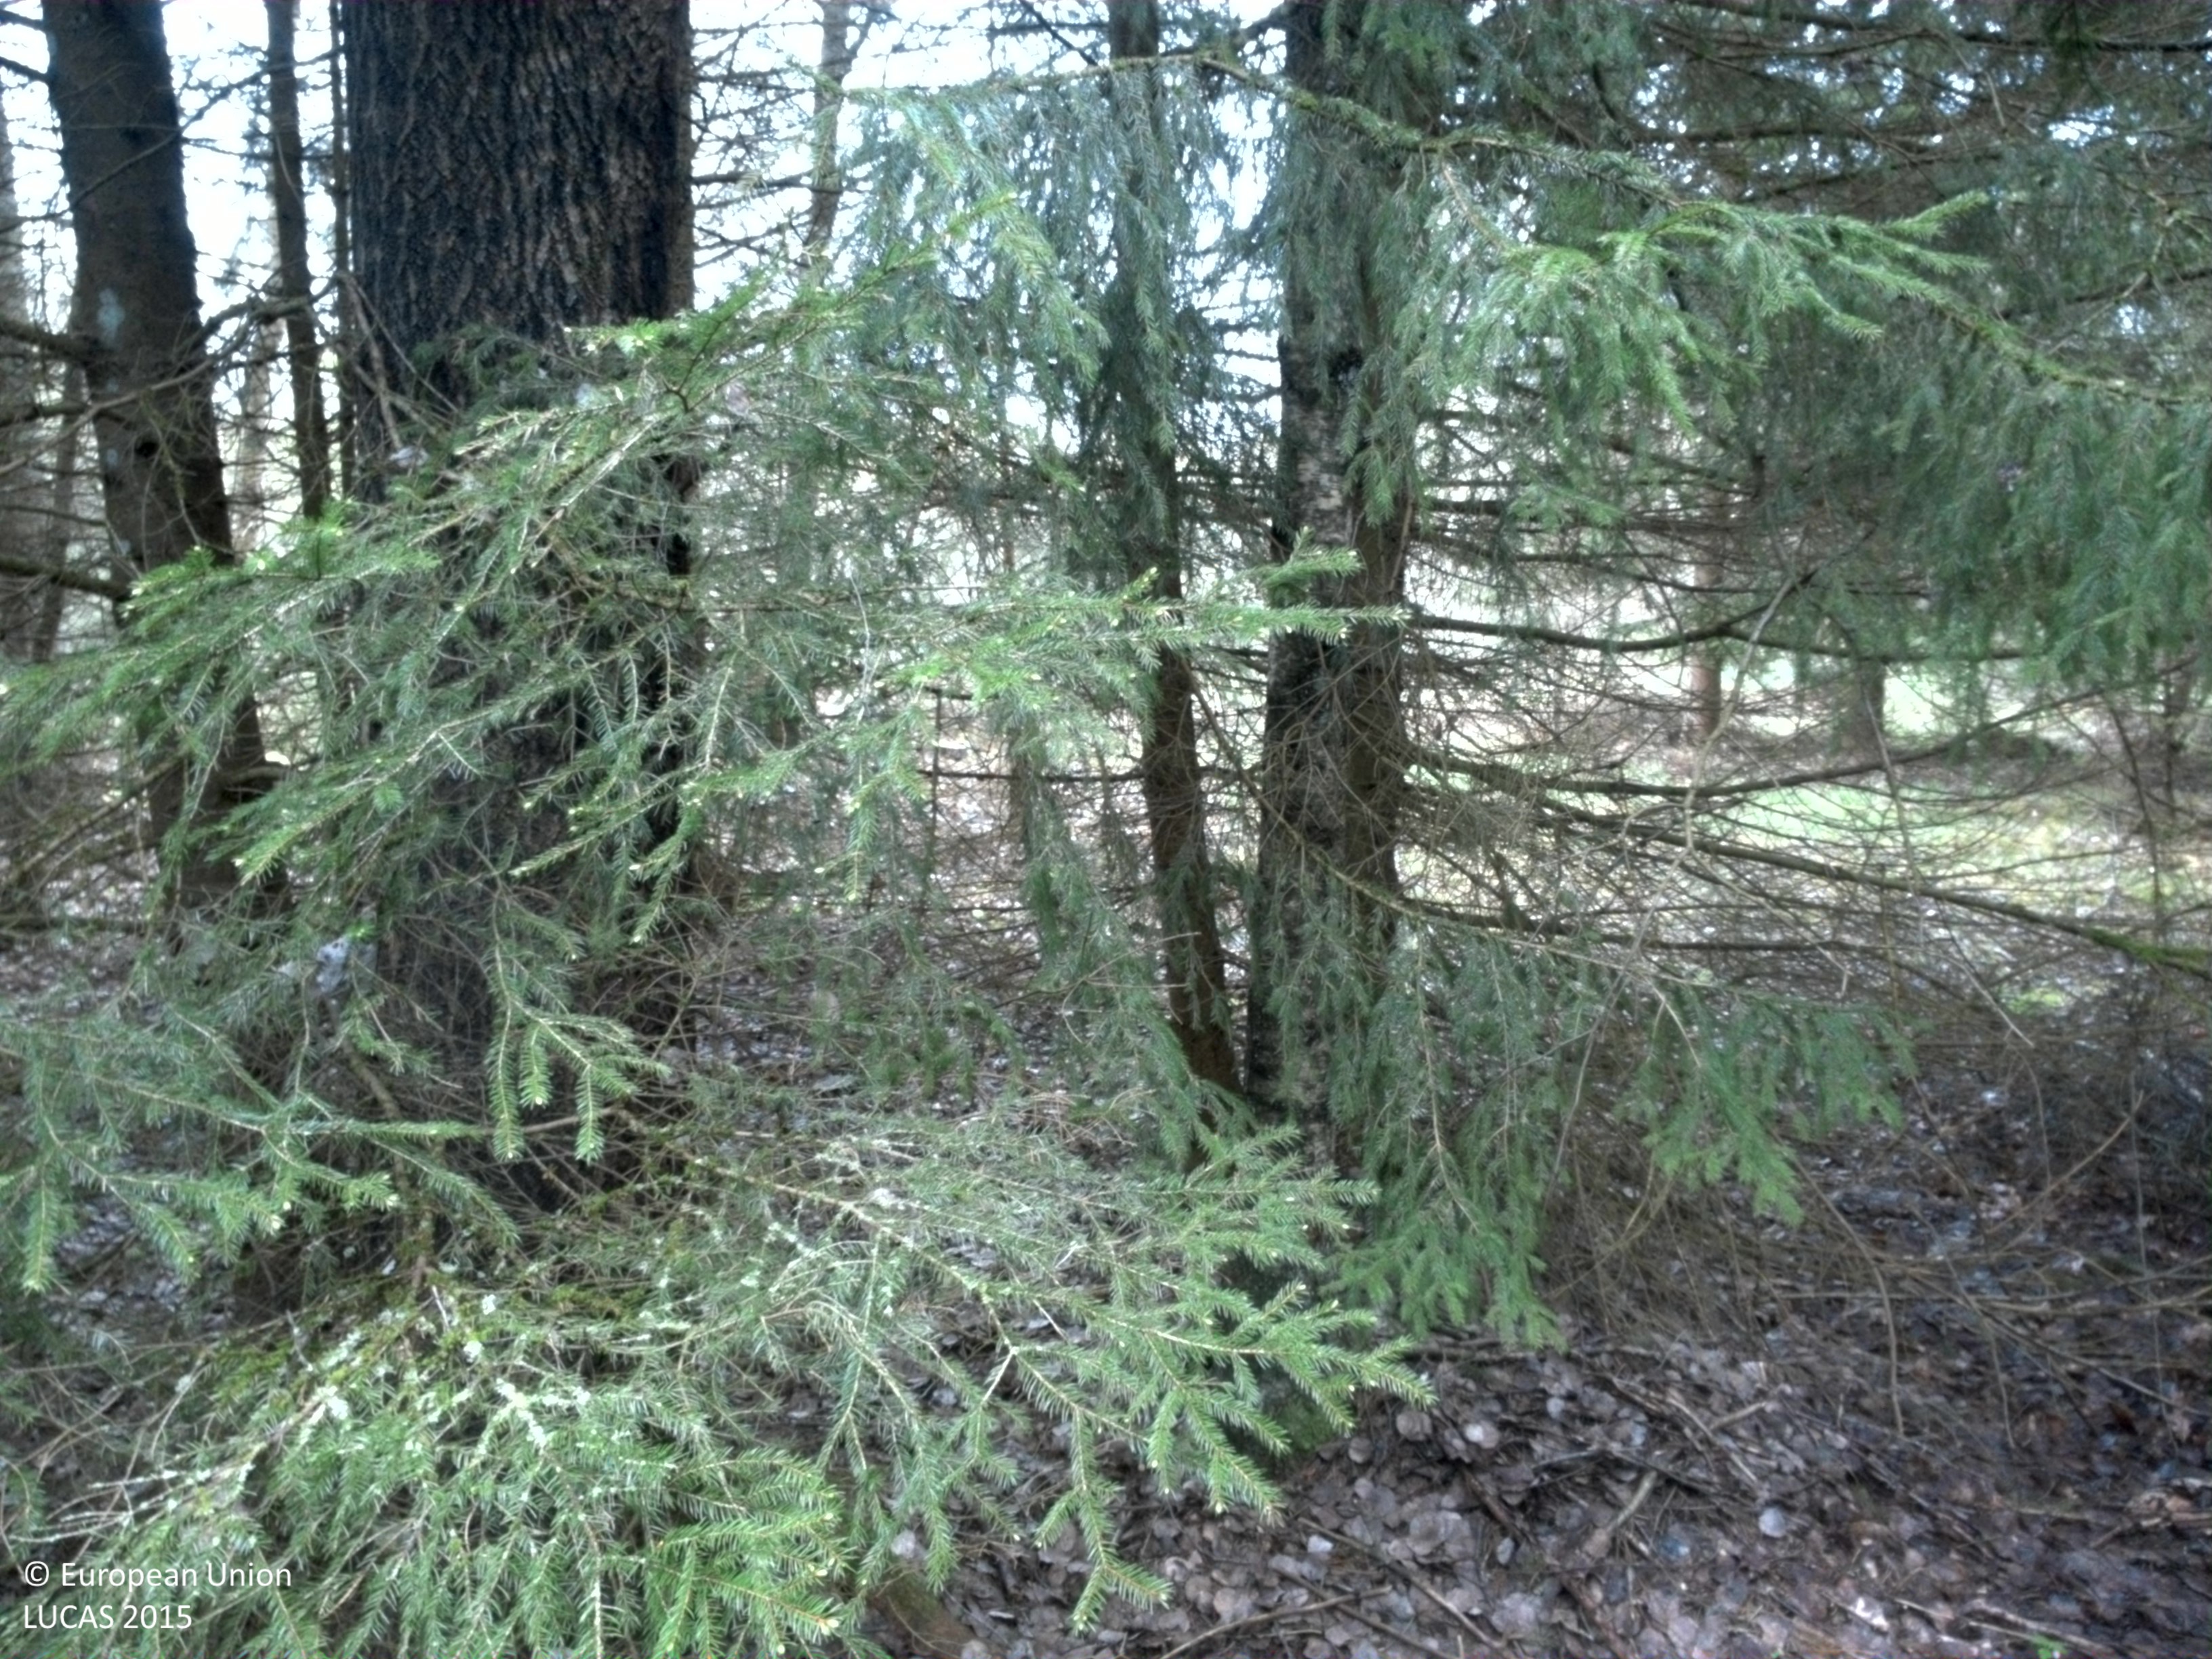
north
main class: Woodland
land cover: Spruce dominated mixed woodland
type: boreal forest
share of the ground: > 75 %
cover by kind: coniferous forest trees 40 %, broadleaved forest trees 40 %, lichens and mosses 20 %
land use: Forestry
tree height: > 5 m
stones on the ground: < 10 %
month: May
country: SE
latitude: 56.6820
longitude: 15.0745
